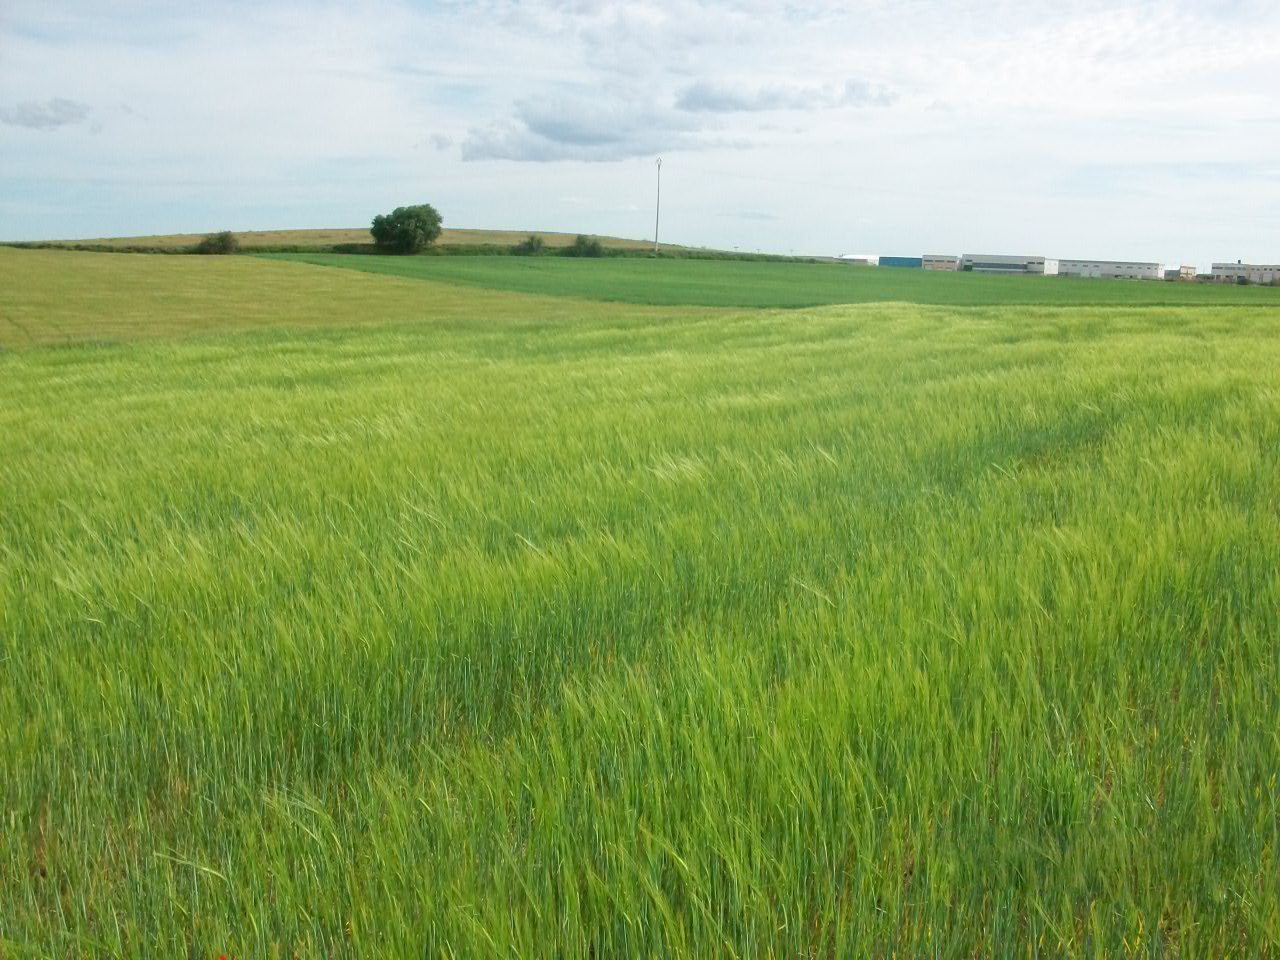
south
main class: Cropland
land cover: Common wheat
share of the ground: > 75 %
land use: Agriculture (excluding fallow land and kitchen gardens)
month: May
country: ES
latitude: 40.0830
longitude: -3.7431
